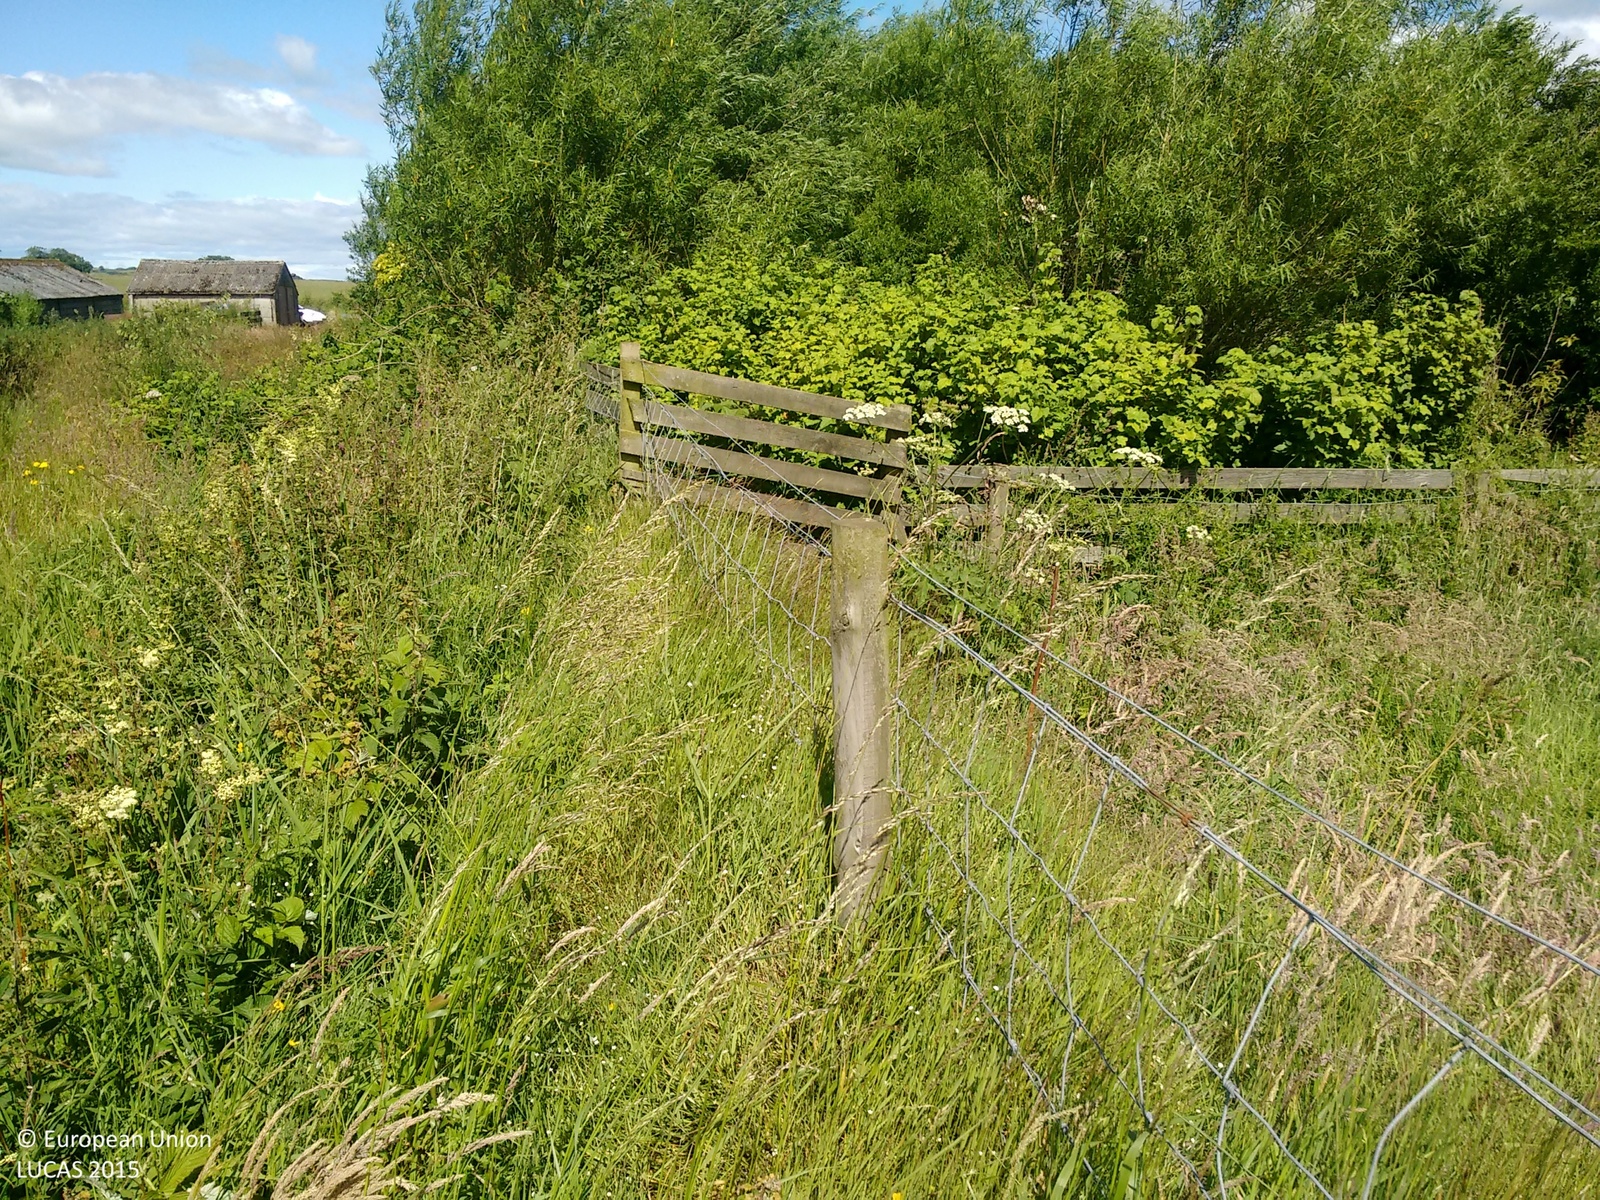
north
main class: Grassland
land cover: Grassland without tree/shrub cover
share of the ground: > 75 %
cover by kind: herbaceous plants 100 %
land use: Residential
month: July
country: GB
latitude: 57.5350
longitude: -1.9875
